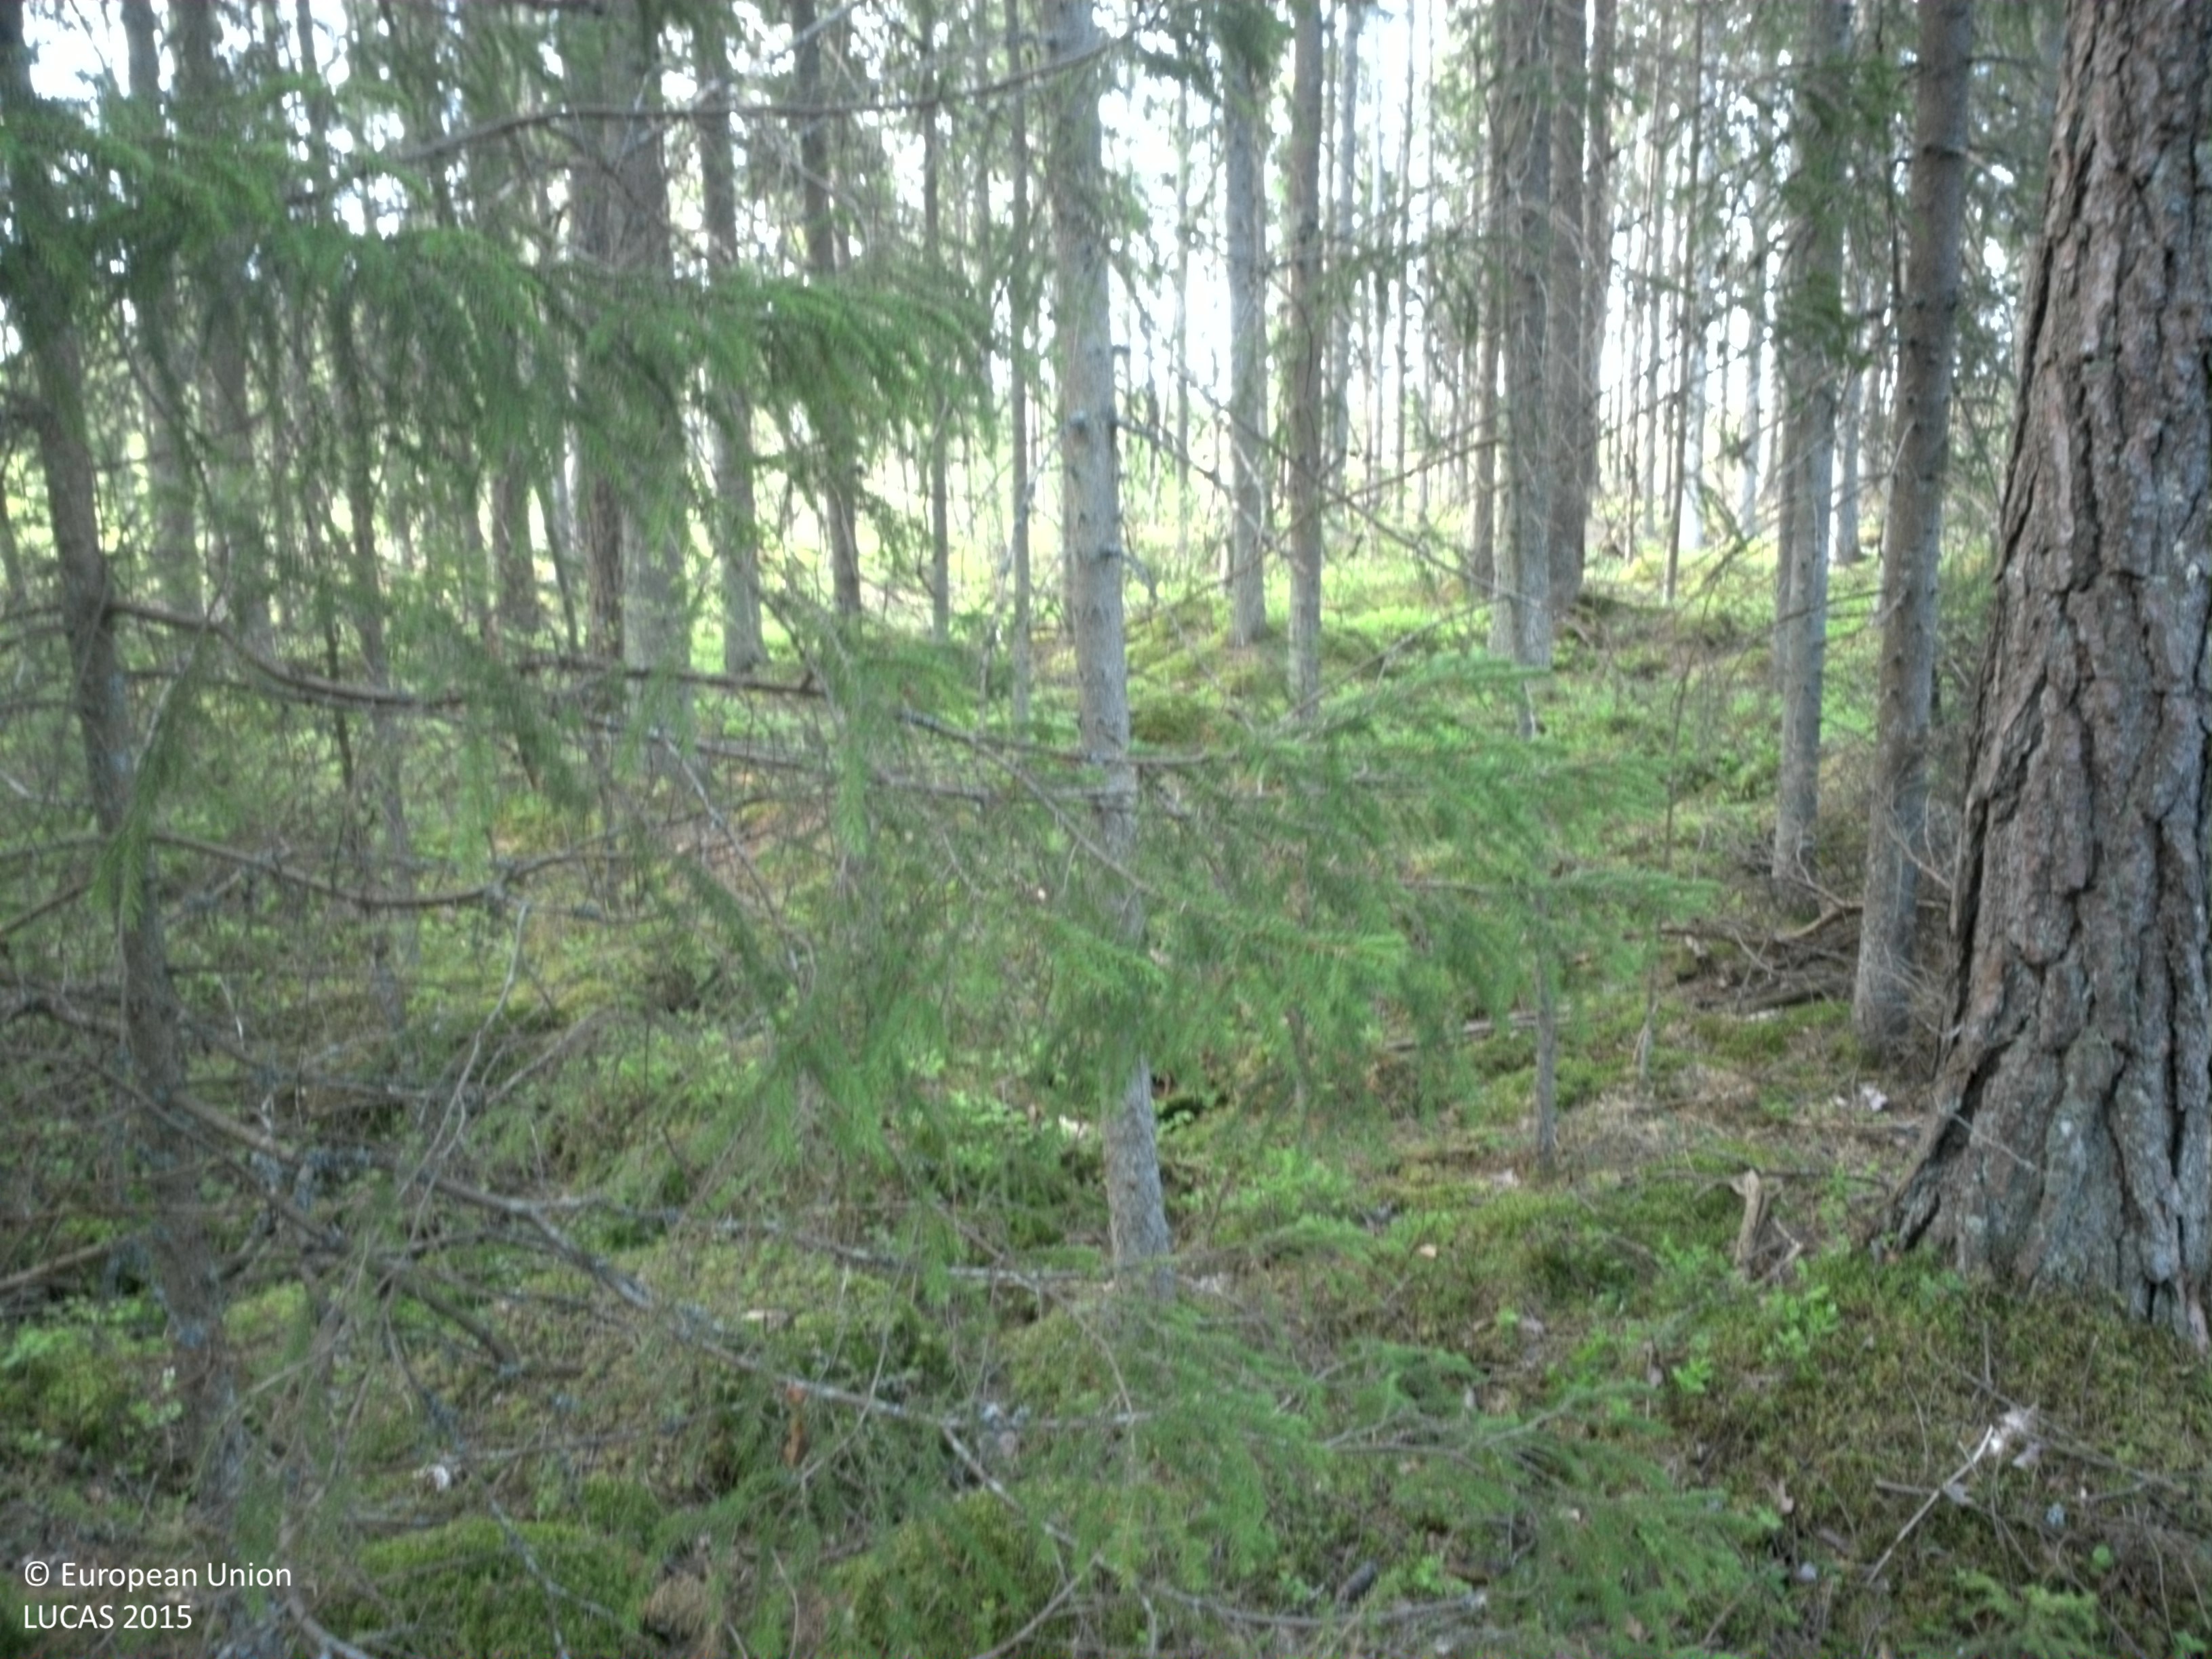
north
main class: Woodland
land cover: Spruce dominated coniferous woodland
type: boreal forest
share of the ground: 50 - 75 %
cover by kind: coniferous forest trees 50 %, shrubs 25 %, lichens and mosses 15 %, herbaceous plants 10 %
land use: Forestry
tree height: > 5 m
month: May
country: SE
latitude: 56.6039
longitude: 15.2273
